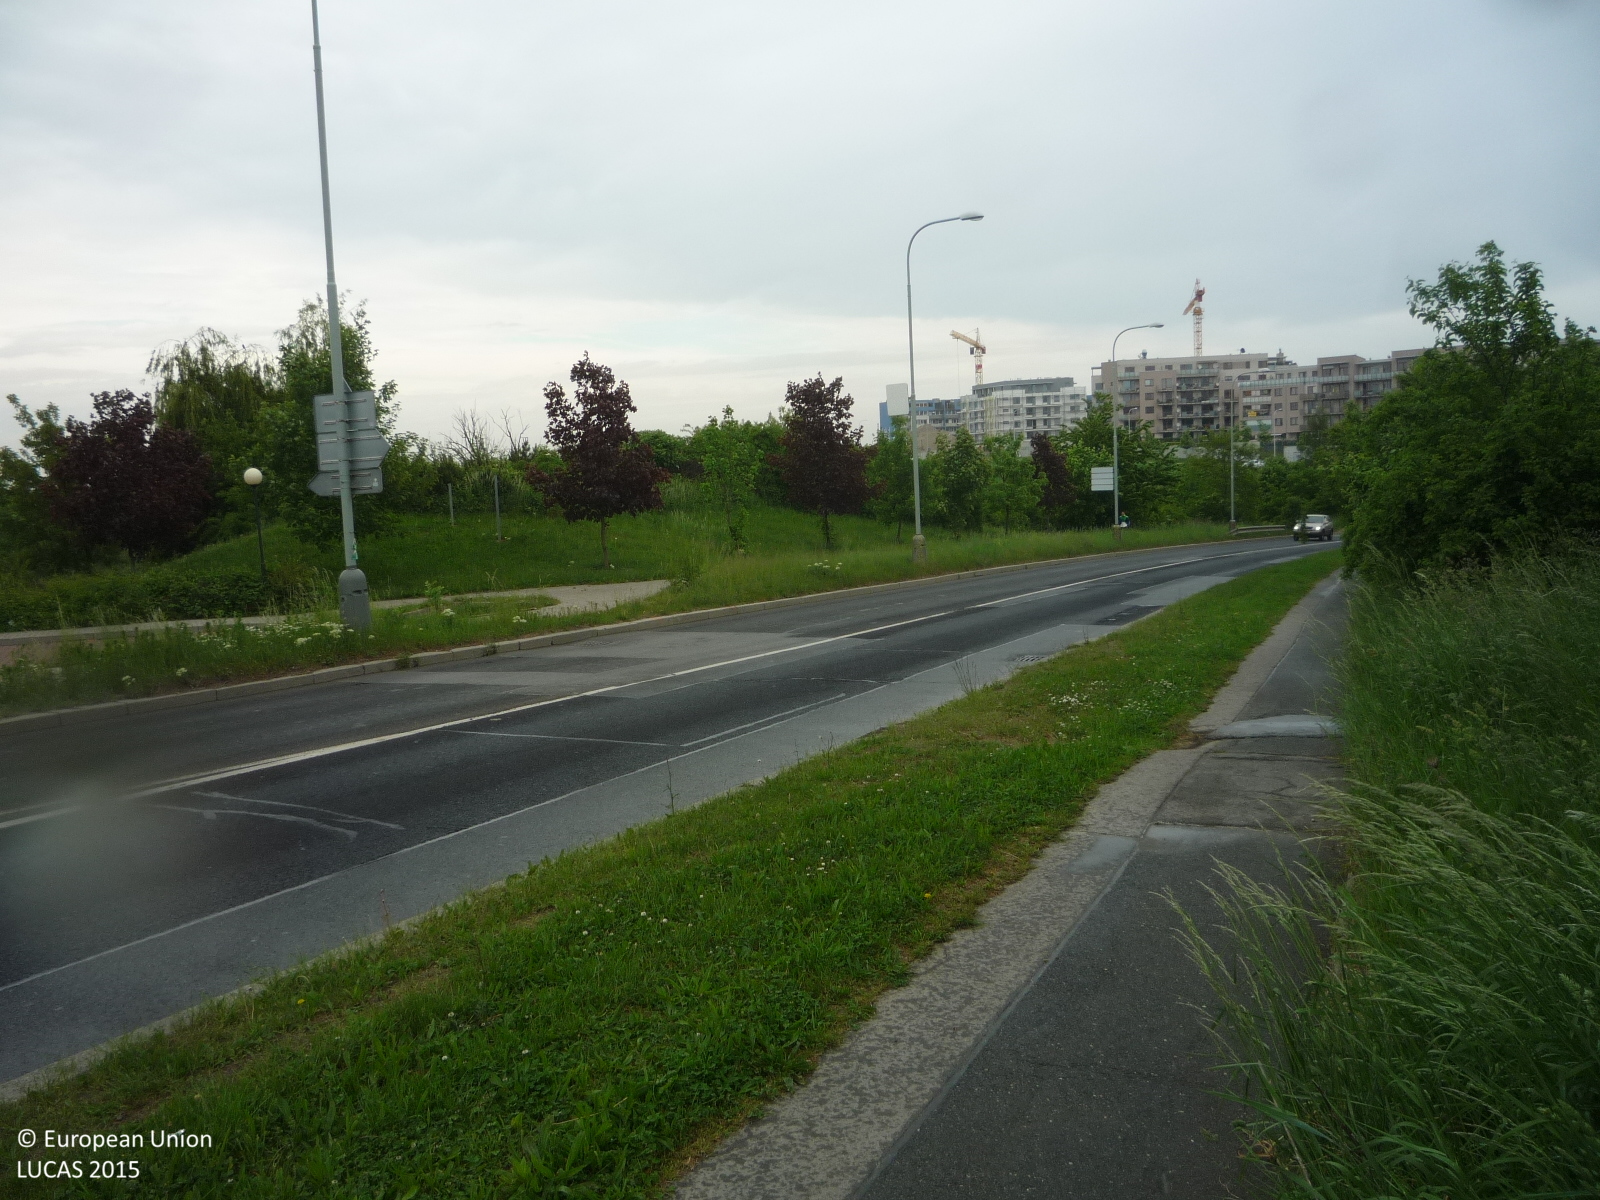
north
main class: Grassland
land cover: Grassland without tree/shrub cover
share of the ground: > 75 %
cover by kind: herbaceous plants 100 %
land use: Abandoned areas
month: May
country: CZ
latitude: 50.0410
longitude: 14.5118
